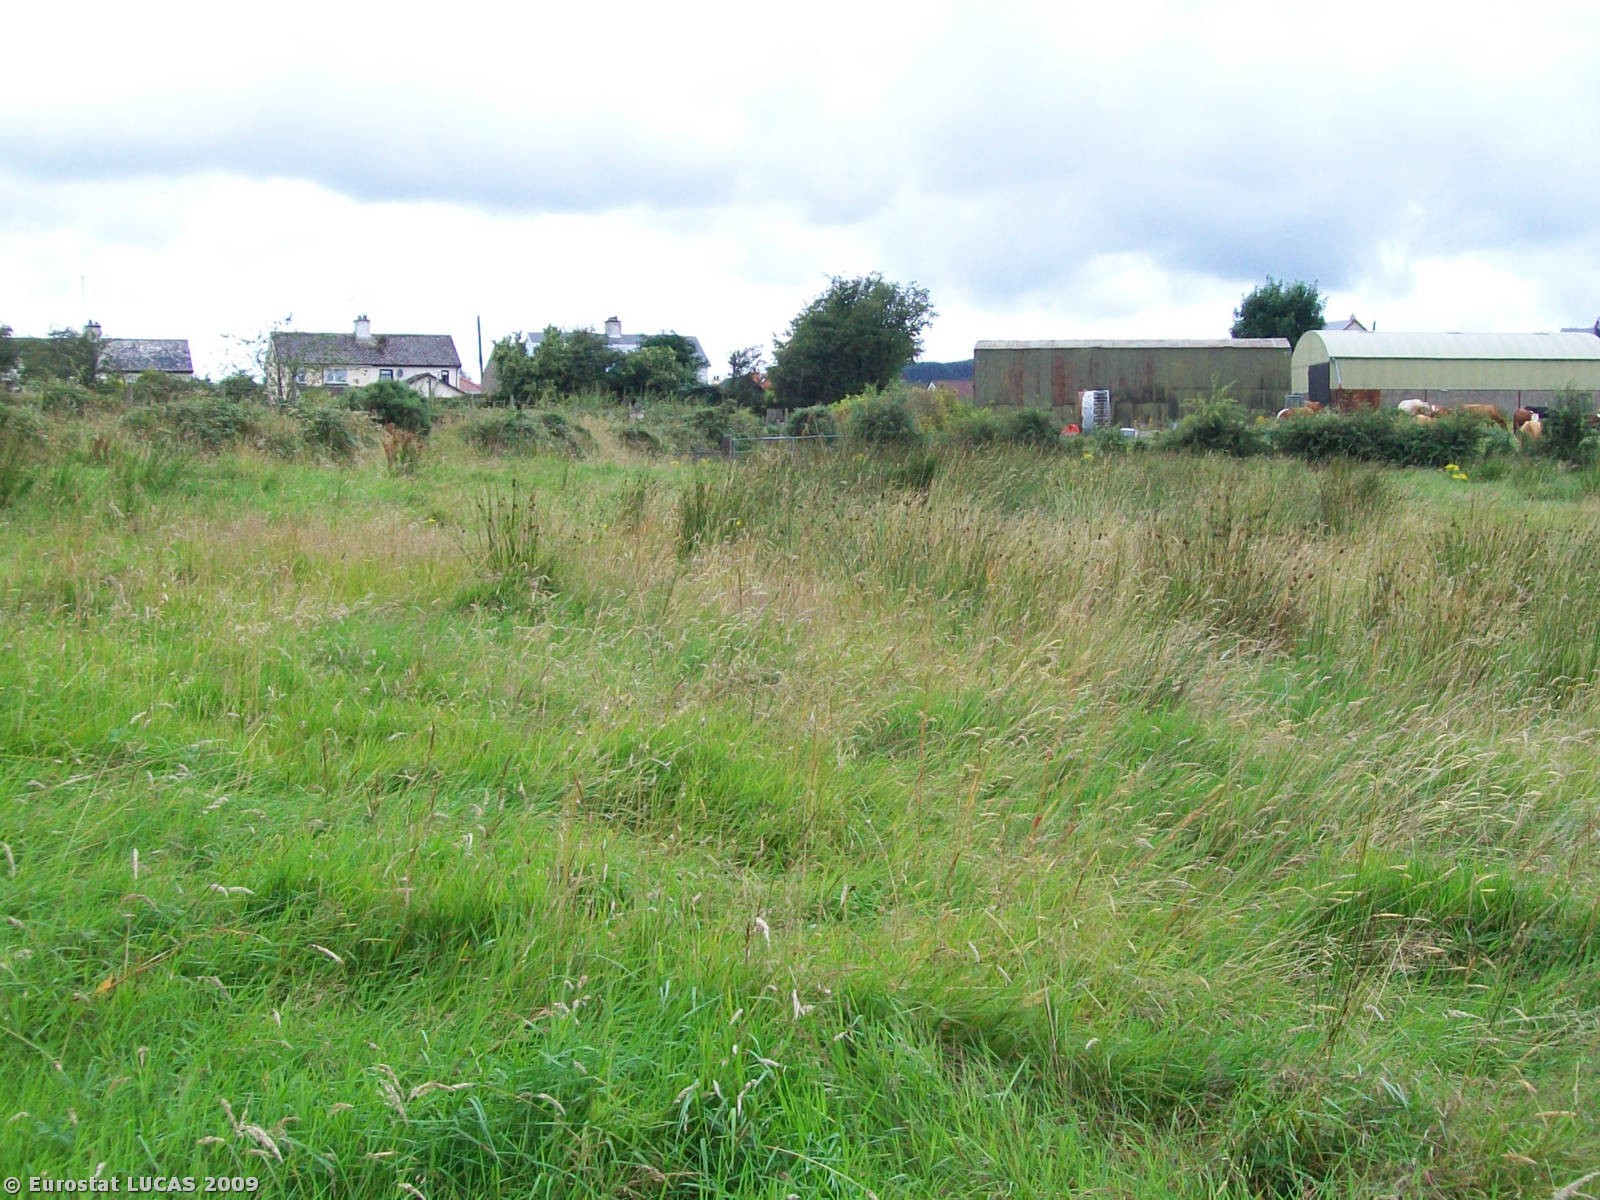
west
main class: Grassland
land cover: Grassland without tree/shrub cover
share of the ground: > 75 %
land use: Agriculture (excluding fallow land and kitchen gardens)
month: August
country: GB
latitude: 54.1968
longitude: -6.5744
